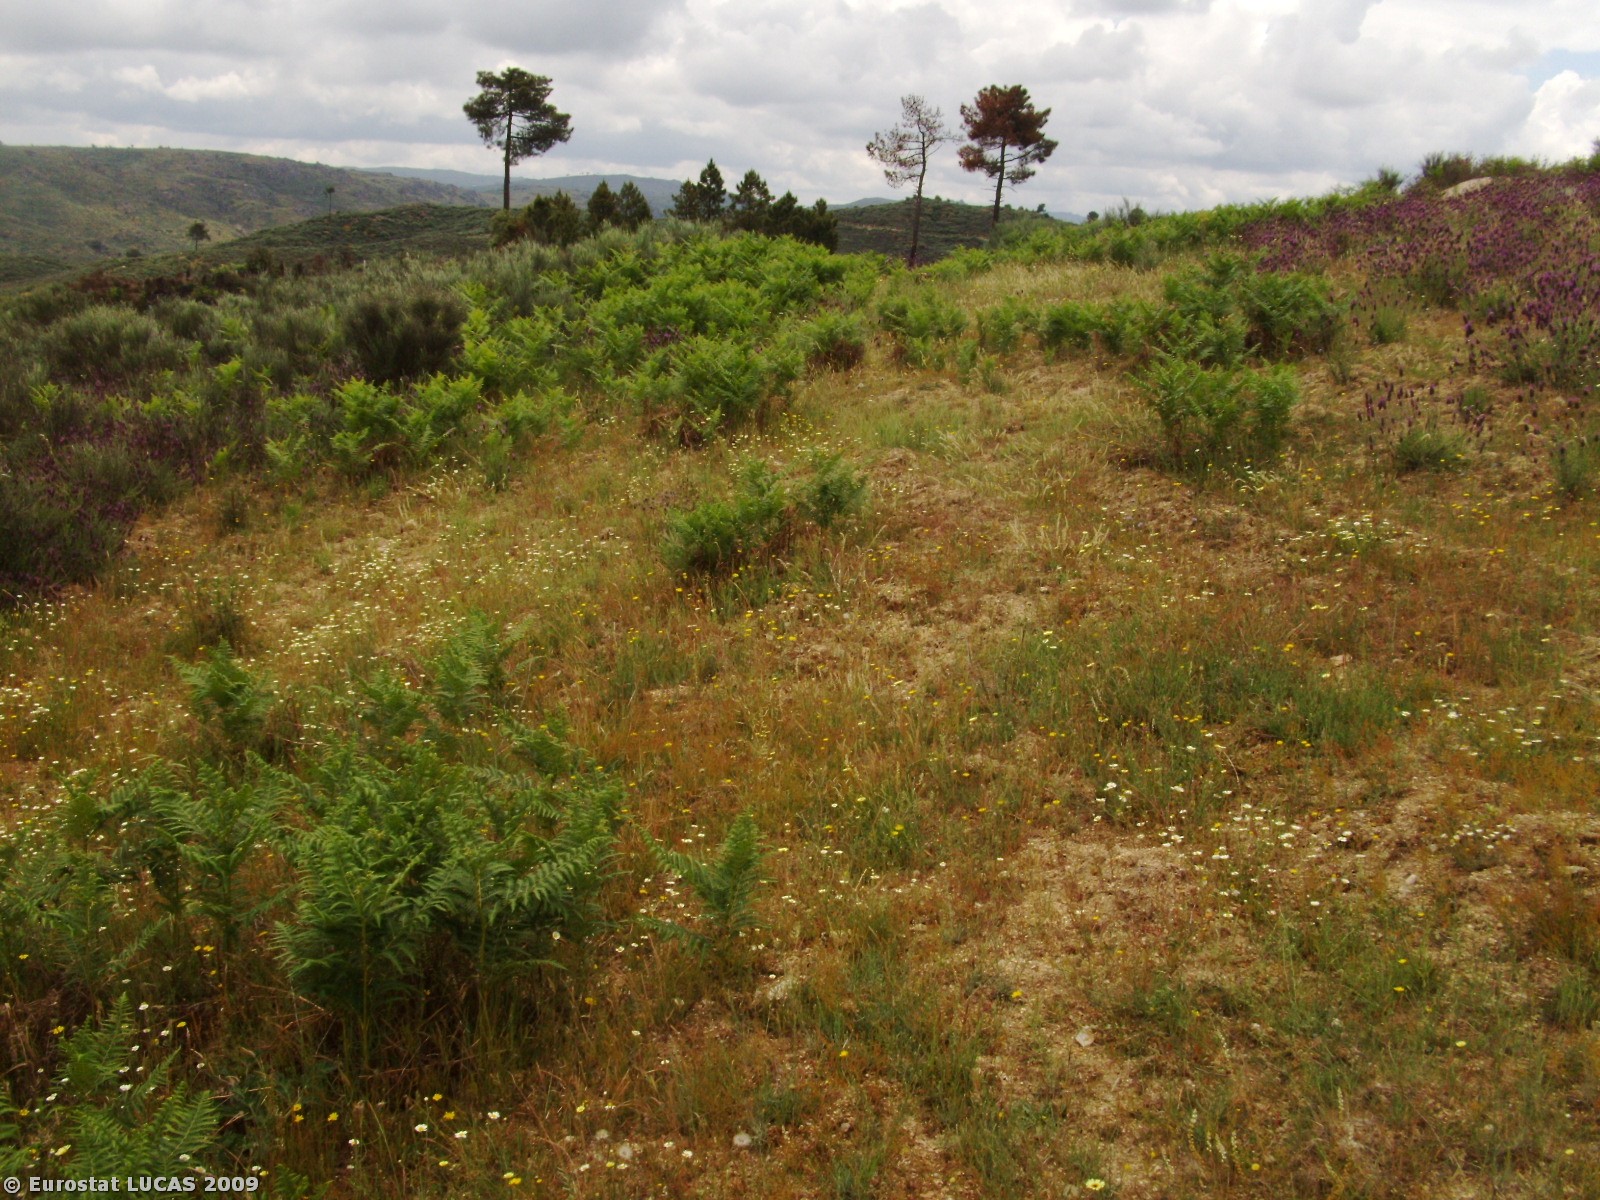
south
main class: Grassland
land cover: Spontaneously vegetated surfaces
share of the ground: > 75 %
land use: Fallow land
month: May
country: PT
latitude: 40.6947
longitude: -7.2799
